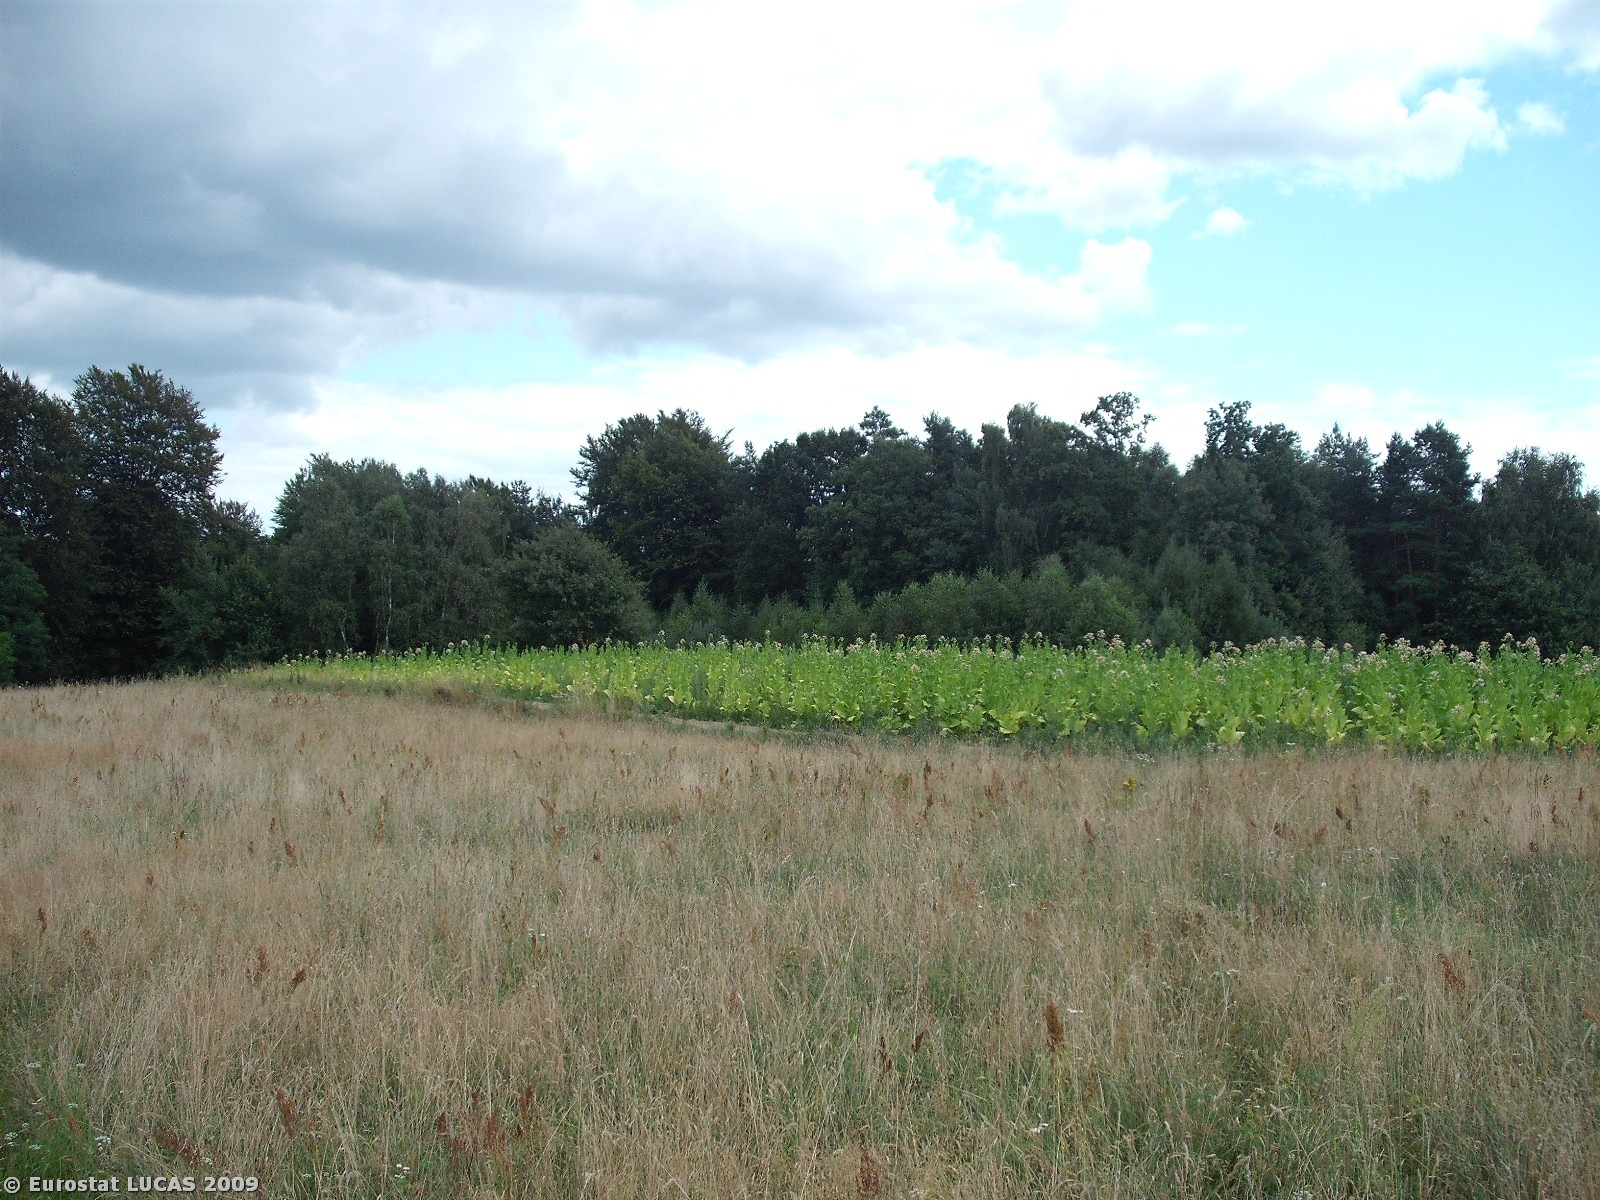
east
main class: Grassland
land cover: Grassland without tree/shrub cover
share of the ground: > 75 %
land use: Agriculture (excluding fallow land and kitchen gardens)
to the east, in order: Grassland without tree/shrub cover; Tobacco; Grass margins; Bare land; Broadleaved woodland; Coniferous woodland; Broadleaved woodland; Grassland with sparse tree/shrub cover; Broadleaved woodland
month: August
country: PL
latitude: 50.1774
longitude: 22.4004
